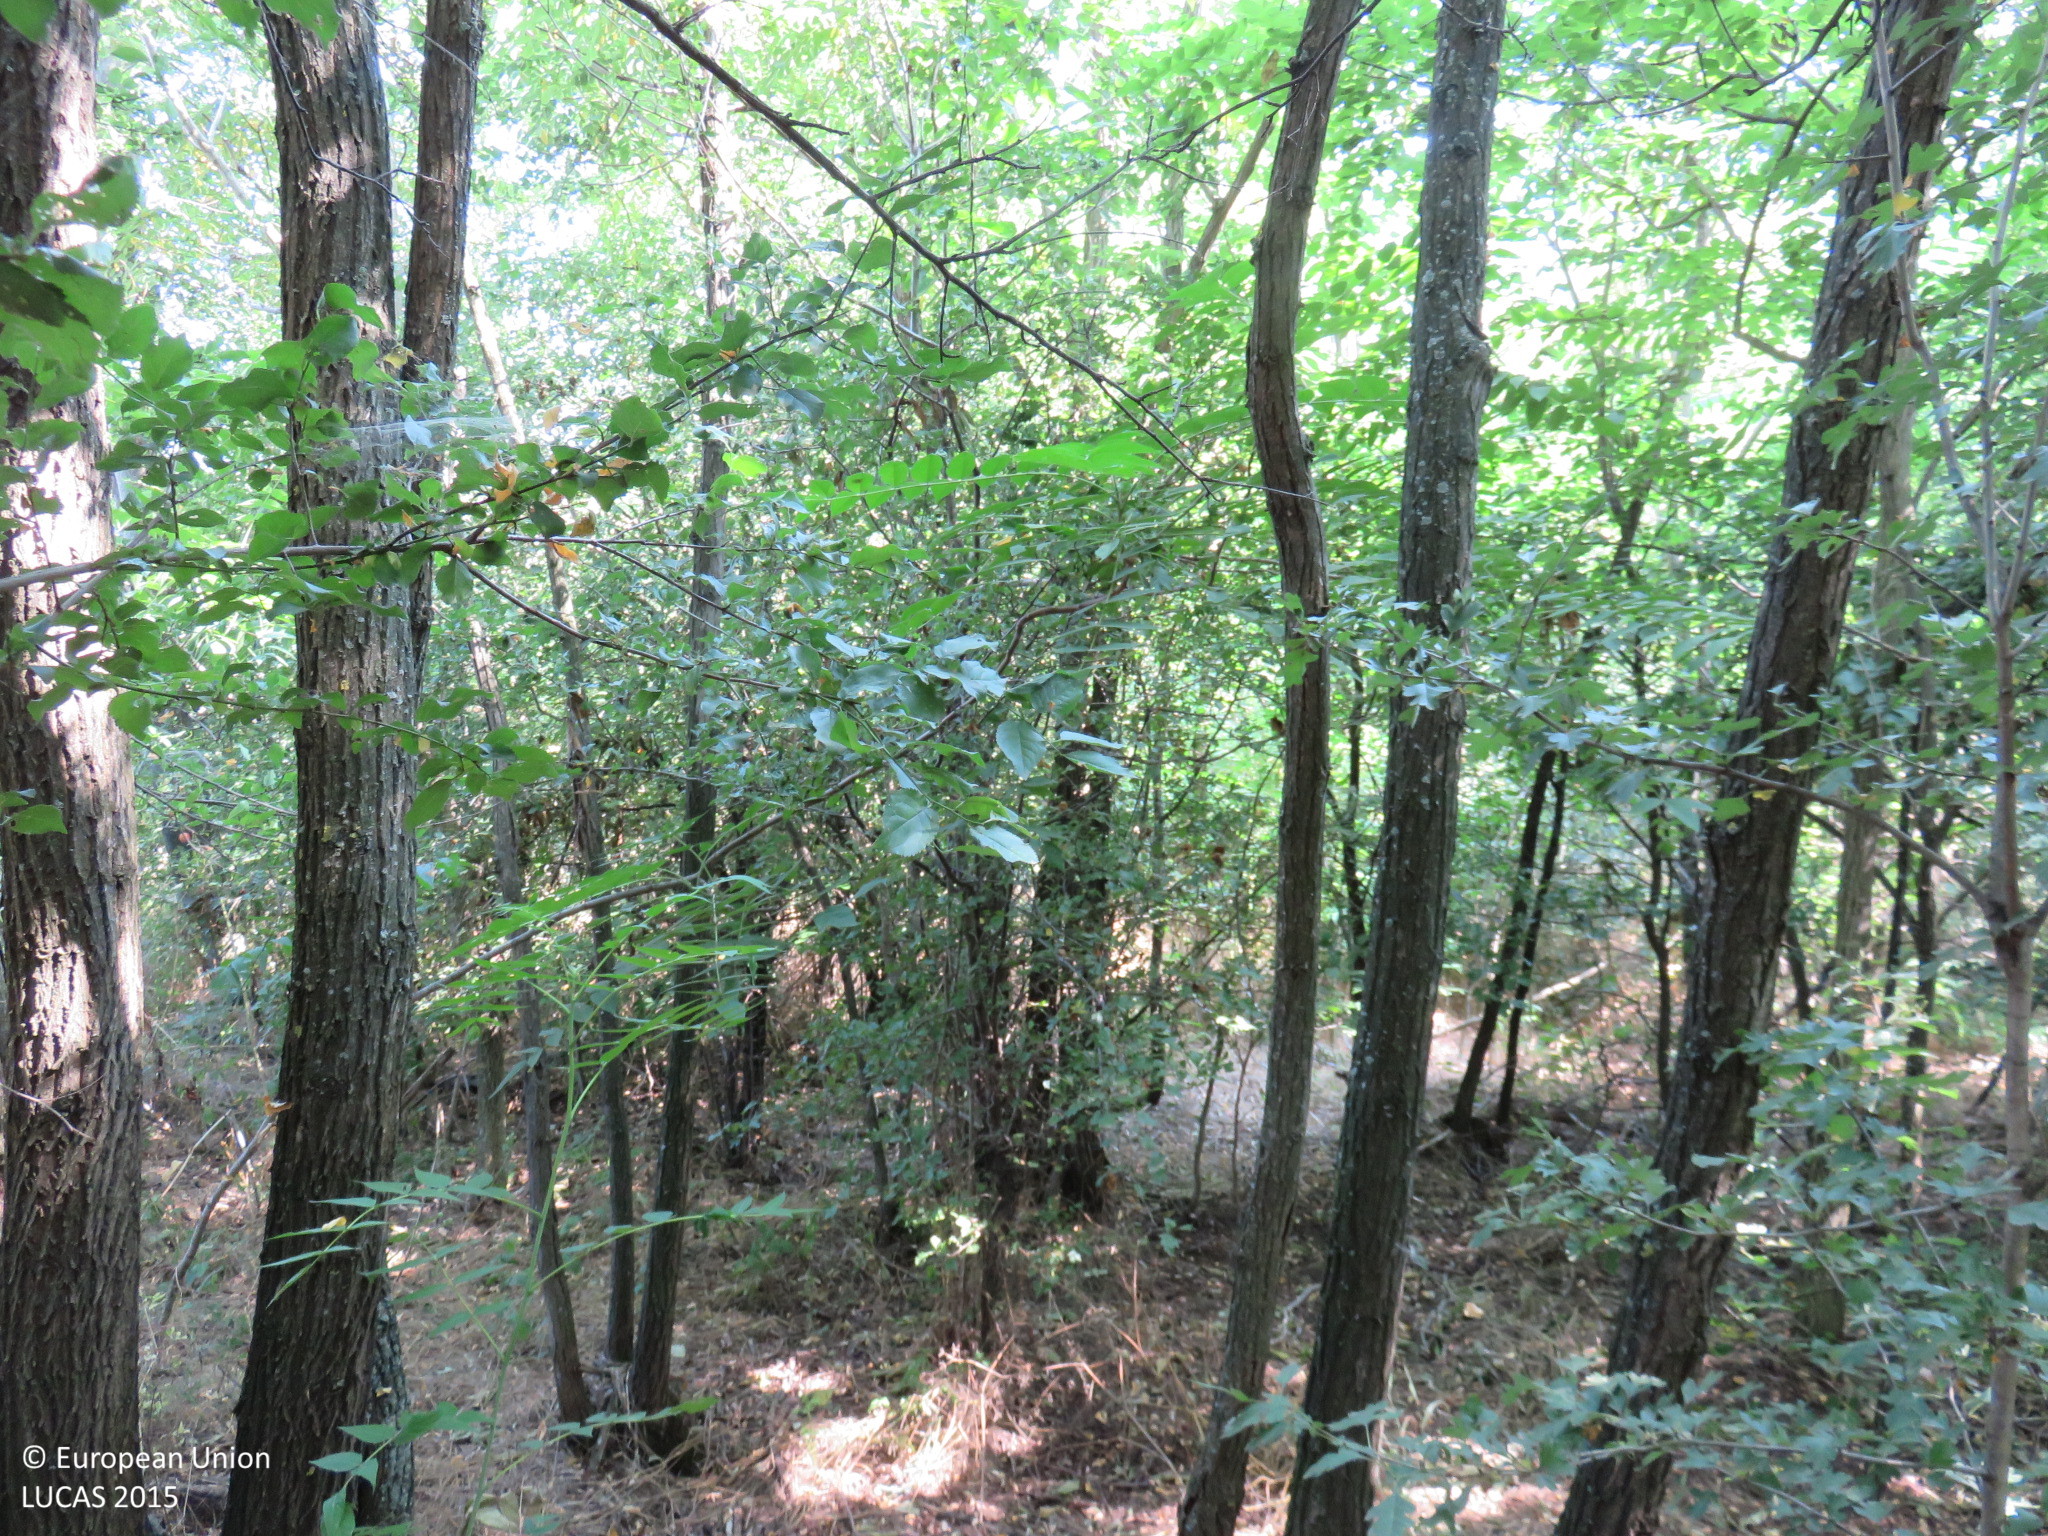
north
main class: Woodland
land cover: Broadleaved woodland
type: mesophytic deciduous forest
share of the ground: > 75 %
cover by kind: broadleaved forest trees 95 %, shrubs 5 %
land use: Forestry
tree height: > 5 m
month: July
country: BG
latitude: 43.5228
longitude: 25.1562
